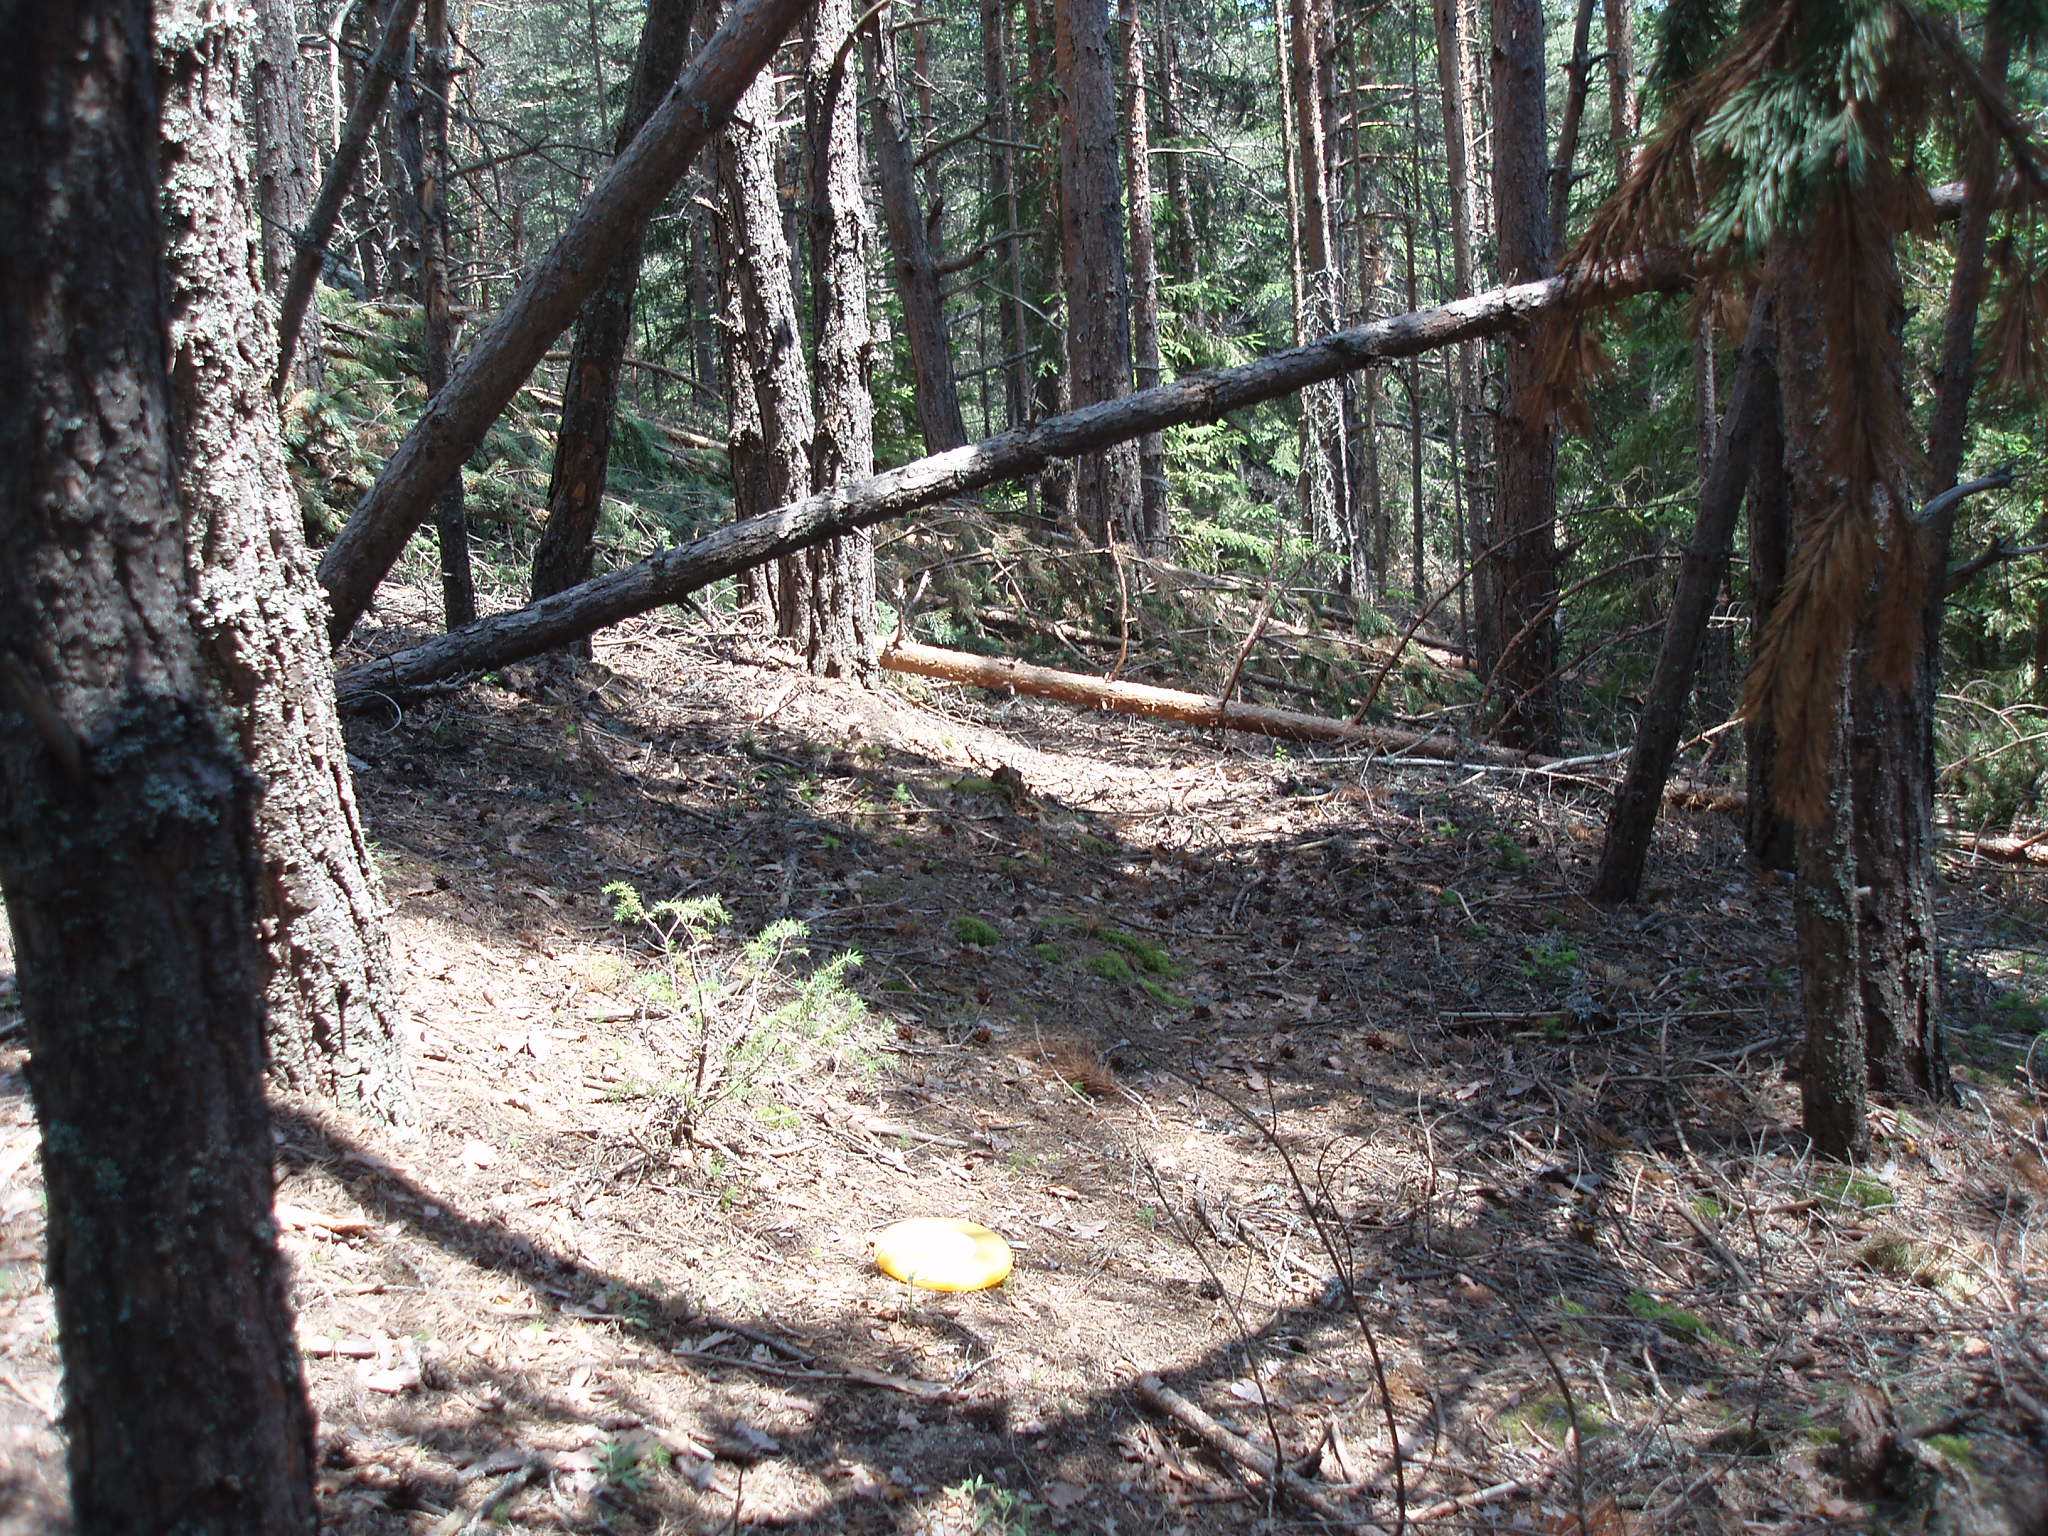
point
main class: Woodland
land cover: Spruce dominated coniferous woodland
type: hemiboreal forest and nemoral coniferous forest and mixed broadleaved-coniferous forest
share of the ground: > 75 %
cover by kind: coniferous forest trees 95 %, unconsolidated bare surface 5 %
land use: Forestry
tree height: > 5 m
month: July
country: BG
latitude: 41.9992
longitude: 23.7846
